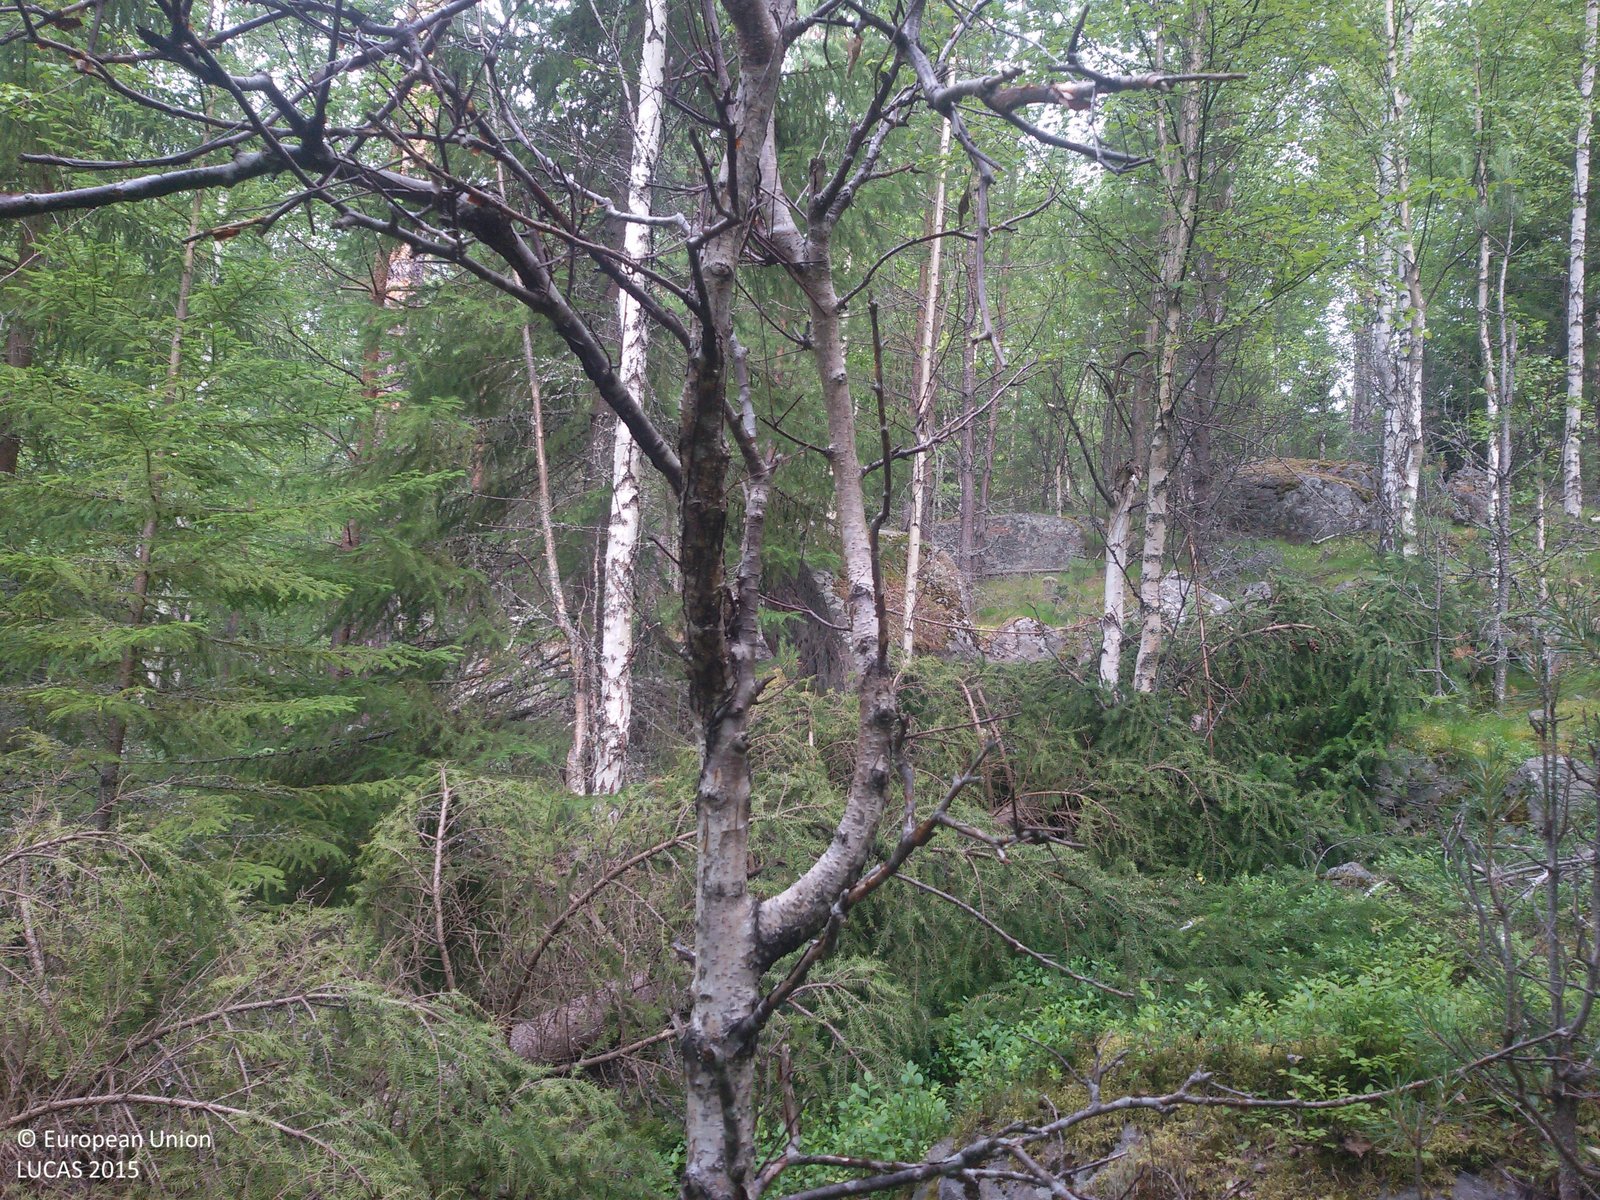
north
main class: Woodland
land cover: Spruce dominated mixed woodland
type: boreal forest
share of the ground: 50 - 75 %
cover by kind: coniferous forest trees 40 %, broadleaved forest trees 35 %, herbaceous plants 15 %, lichens and mosses 10 %
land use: Forestry
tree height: > 5 m
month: July
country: SE
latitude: 60.5506
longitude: 15.2936
